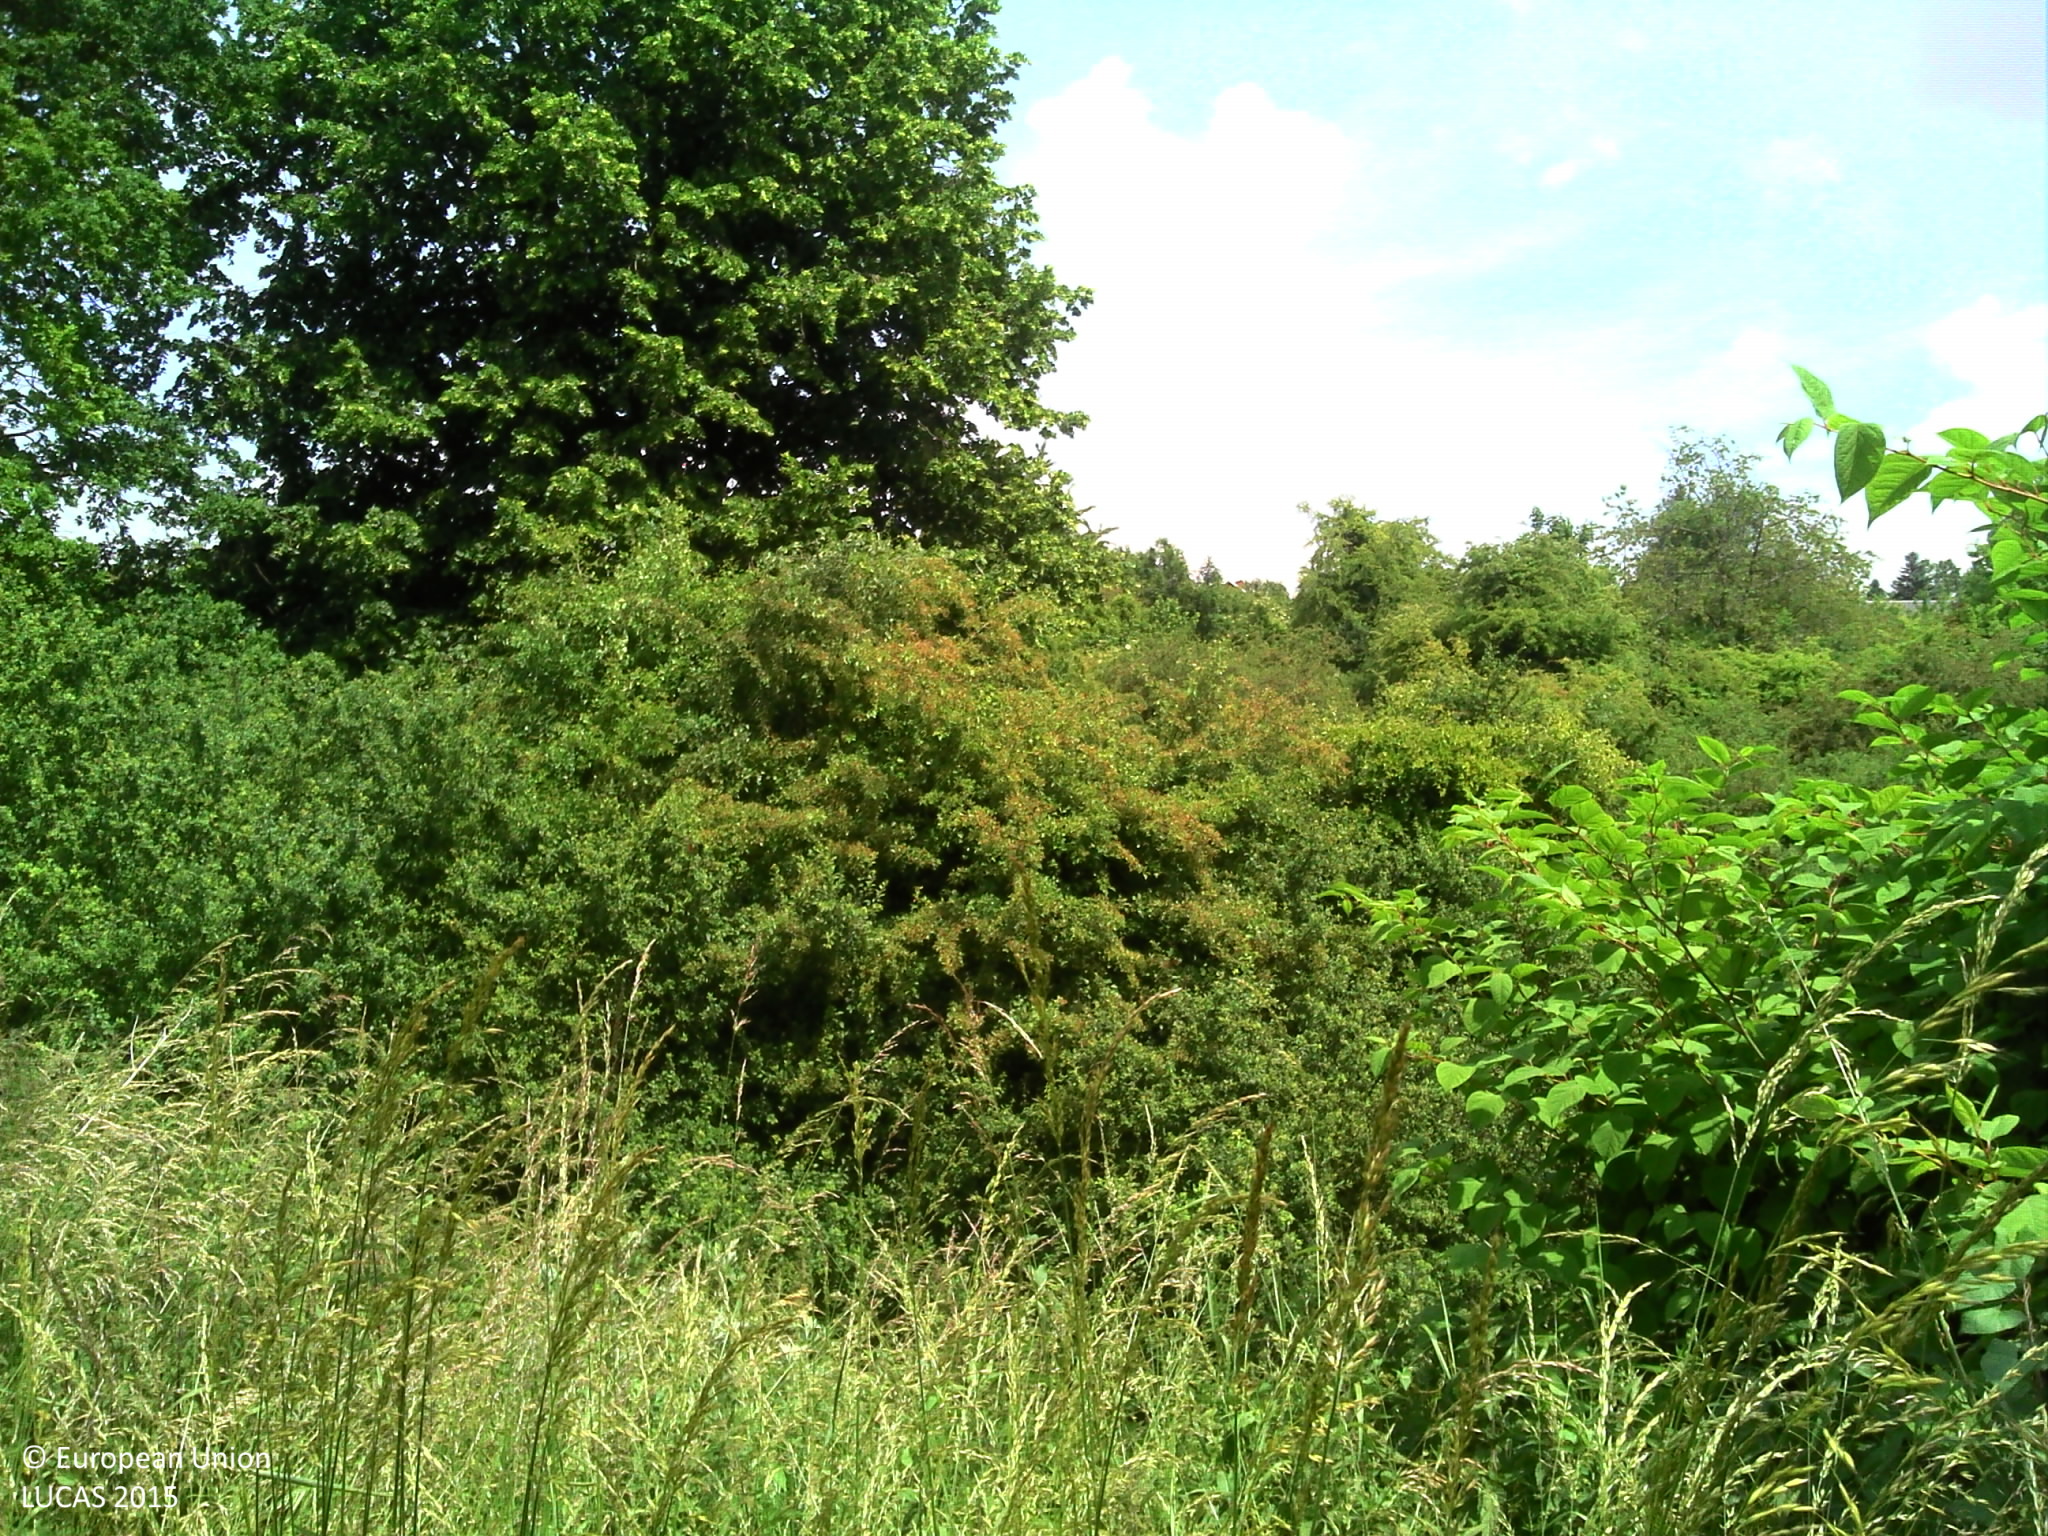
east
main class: Grassland
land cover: Grassland with sparse tree/shrub cover
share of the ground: > 75 %
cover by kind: herbaceous plants 85 %, shrubs 10 %, broadleaved forest trees 5 %
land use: Sport
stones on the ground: < 10 %
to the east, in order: Grassland with sparse tree/shrub cover; Broadleaved woodland; Grassland without tree/shrub cover; Tracks; Grassland without tree/shrub cover; Artificial constructions in urban areas
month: June
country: BE
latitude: 50.4837
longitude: 4.8809
